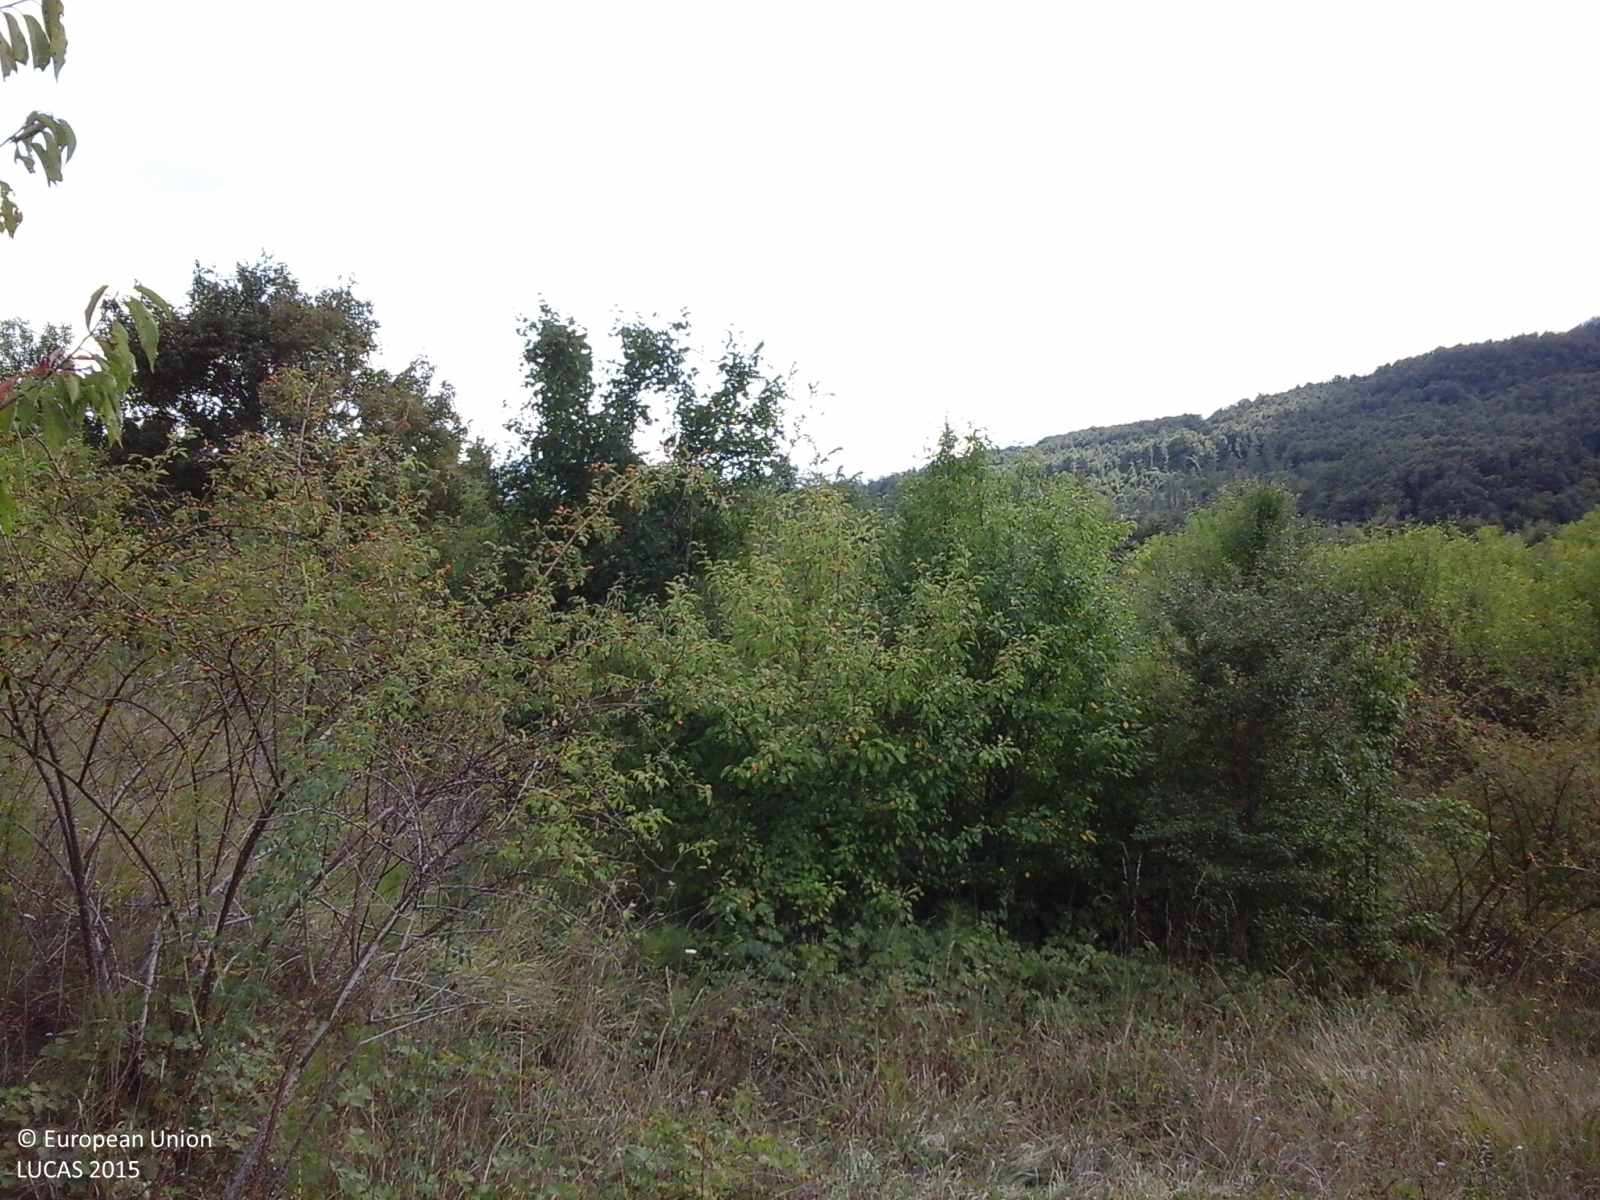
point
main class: Woodland
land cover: Broadleaved woodland
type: thermophilous deciduous forest
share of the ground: > 75 %
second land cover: Grassland without tree/shrub cover
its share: > 75 %
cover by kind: broadleaved forest trees 70 %, shrubs 20 %, herbaceous plants 10 %
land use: Forestry
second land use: Agriculture (excluding fallow land and kitchen gardens)
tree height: > 5 m
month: August
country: IT
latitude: 41.7336
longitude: 14.2293
